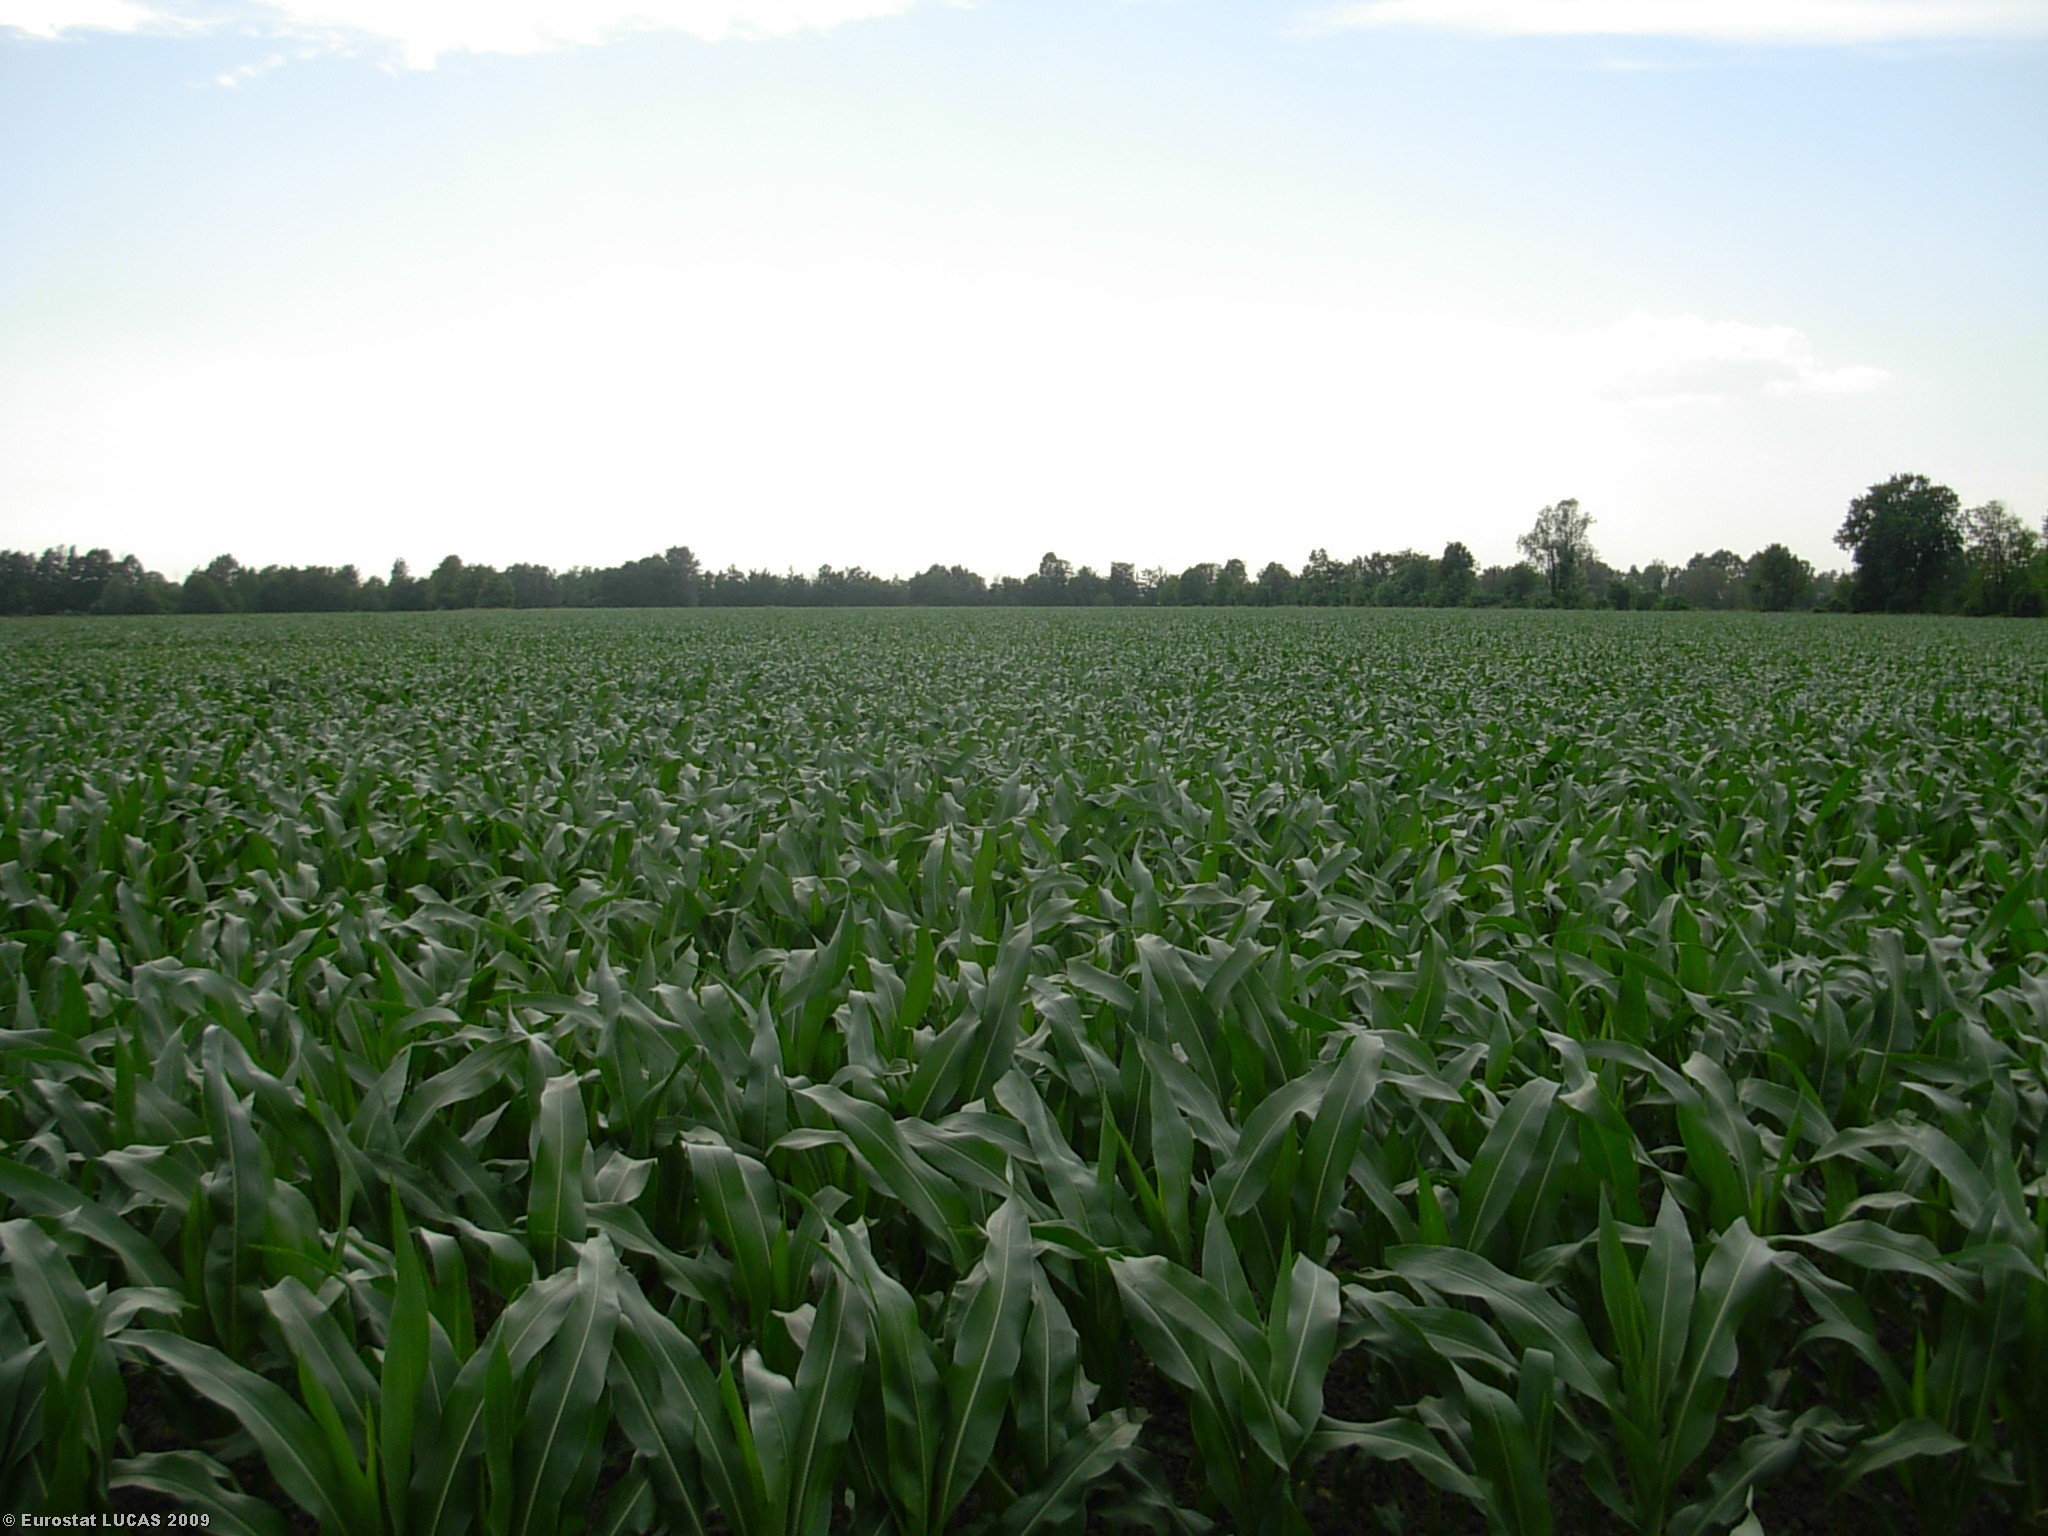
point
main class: Cropland
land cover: Maize
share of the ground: > 75 %
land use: Agriculture (excluding fallow land and kitchen gardens)
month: May
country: IT
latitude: 45.3963
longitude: 10.0382
